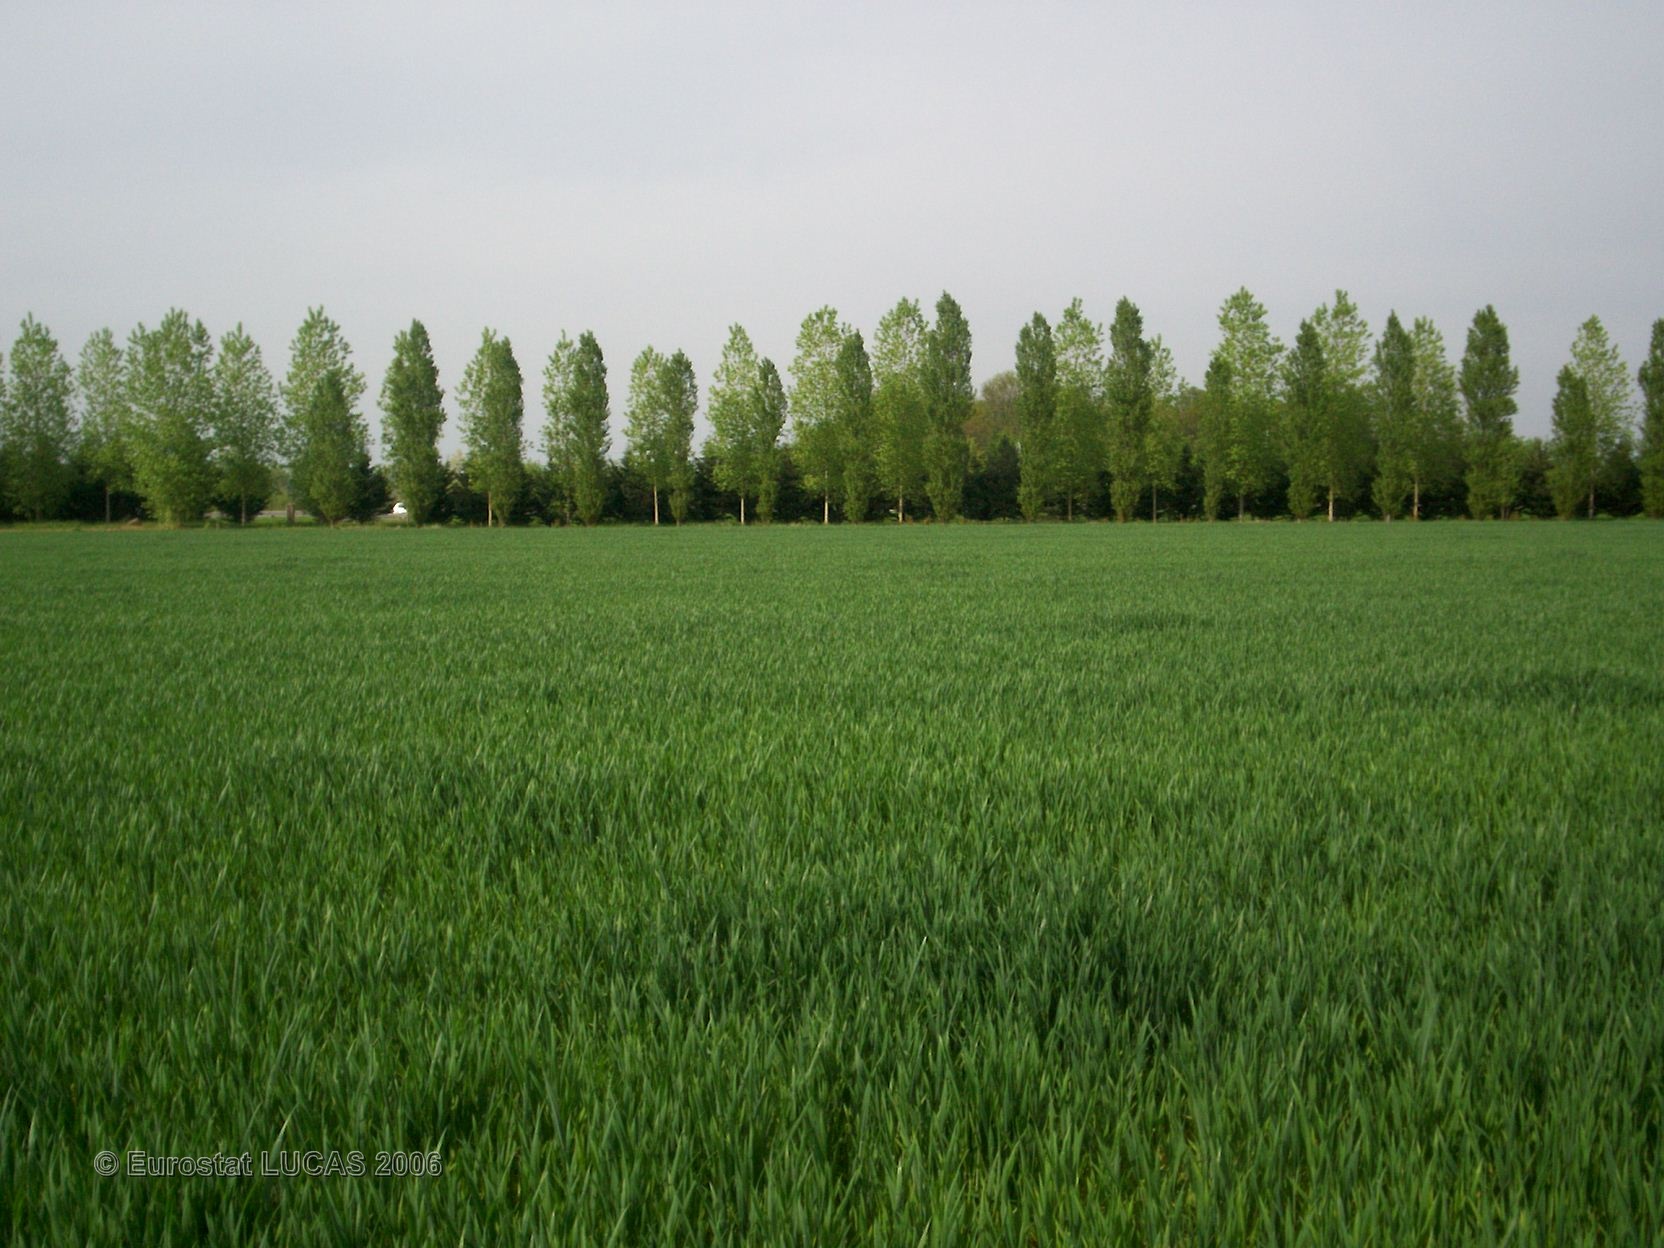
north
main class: Cropland
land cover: Common wheat
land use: Agriculture (excluding fallow land and kitchen gardens)
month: May
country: FR
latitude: 48.7285
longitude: 2.7988
